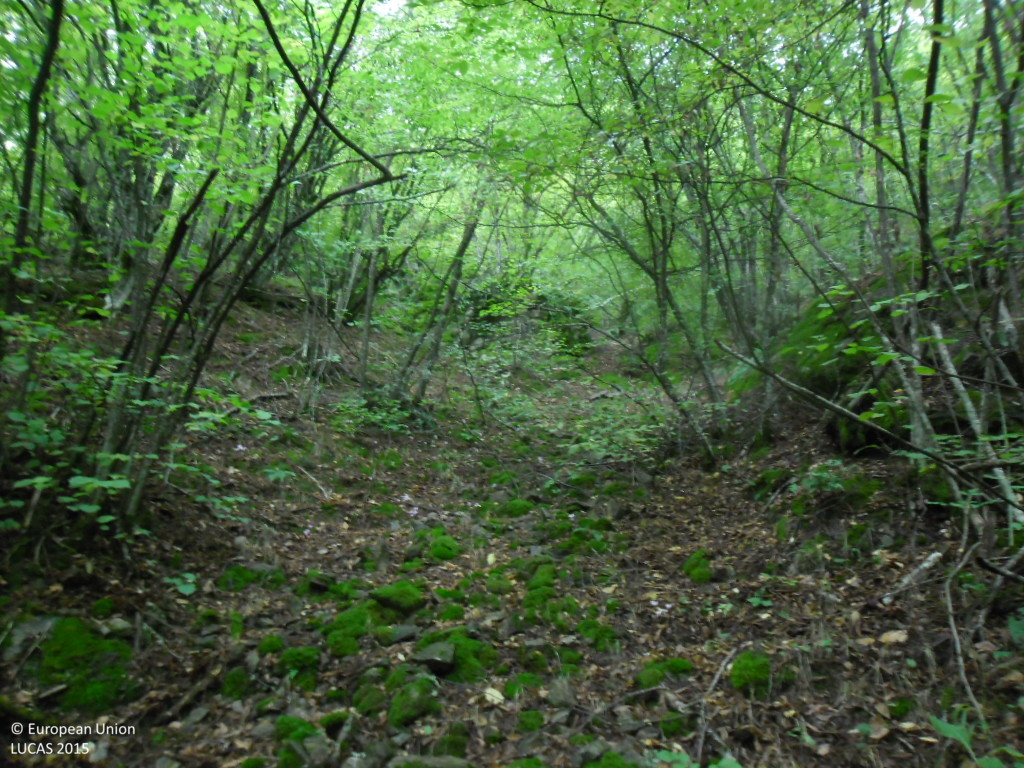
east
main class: Woodland
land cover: Broadleaved woodland
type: mesophytic deciduous forest
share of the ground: > 75 %
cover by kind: broadleaved forest trees 90 %, unconsolidated bare surface 10 %
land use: Forestry
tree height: > 5 m
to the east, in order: Broadleaved woodland; Rivers and streams; Broadleaved woodland
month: September
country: BG
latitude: 41.3574
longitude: 22.9851
